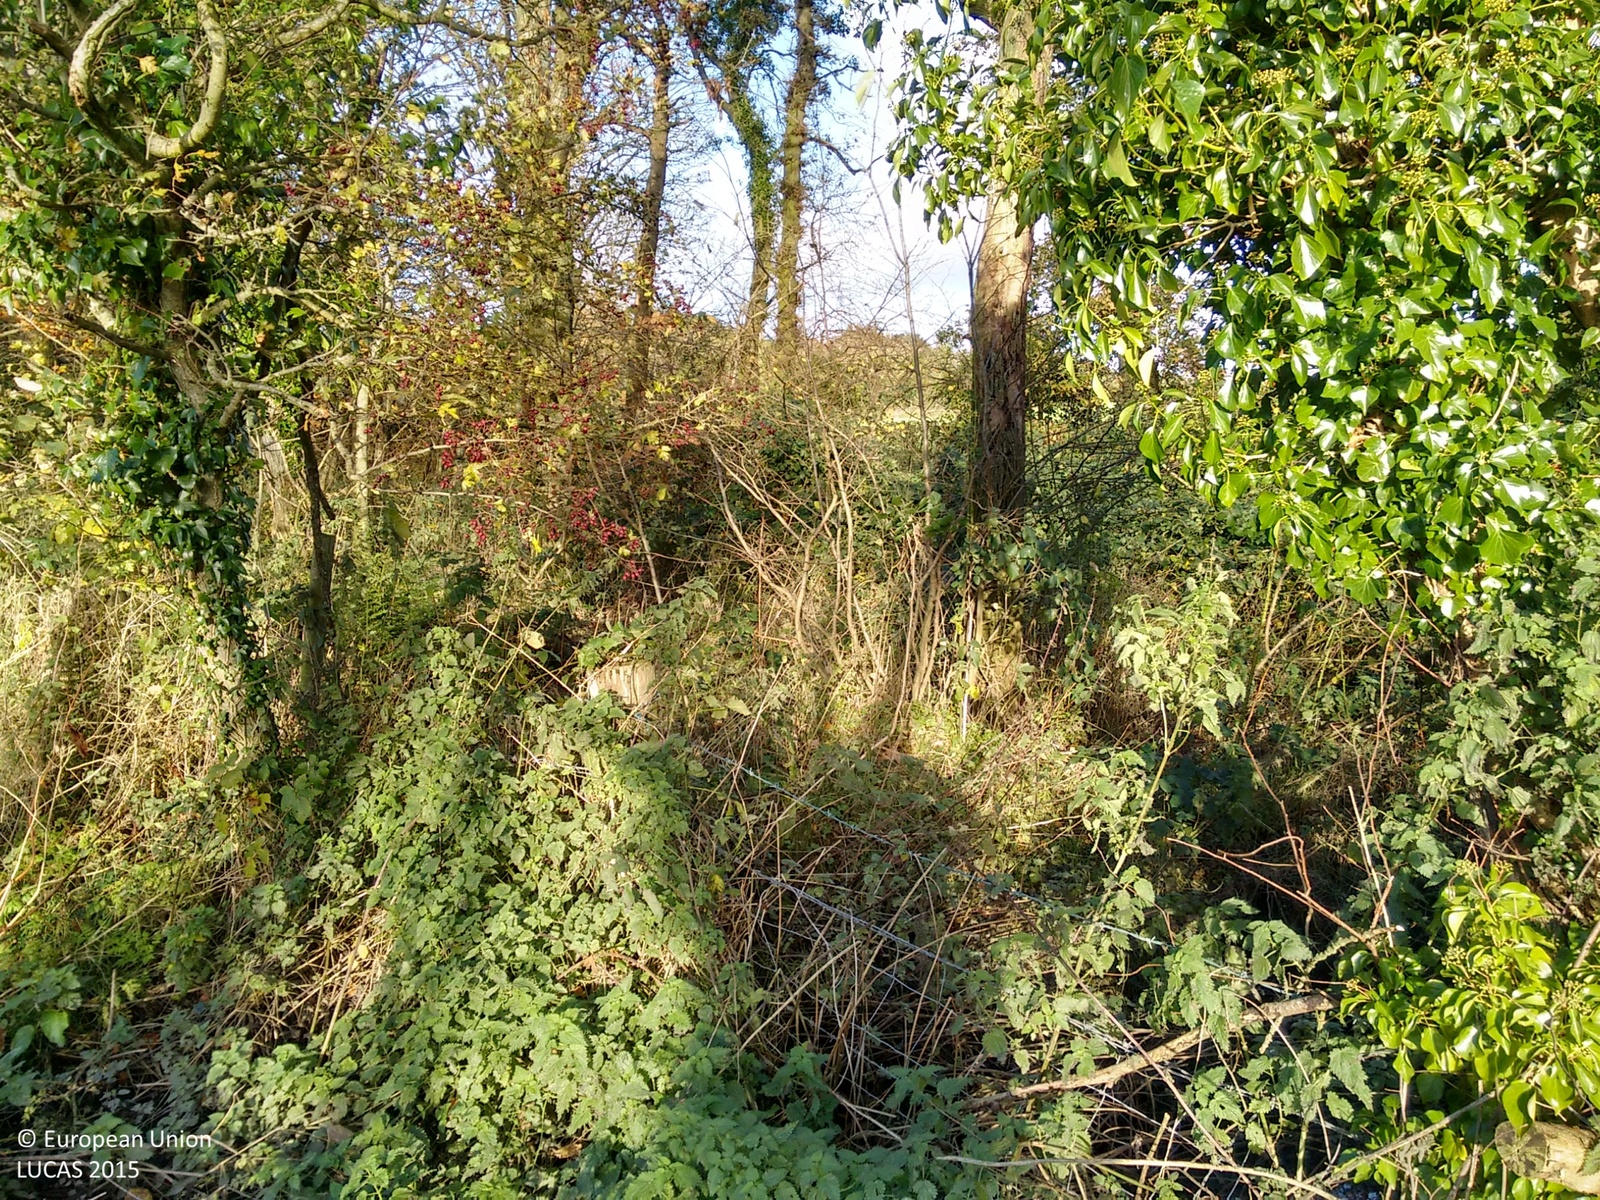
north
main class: Woodland
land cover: Broadleaved woodland
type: exotic forest
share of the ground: > 75 %
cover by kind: broadleaved forest trees 90 %, shrubs 5 %, herbaceous plants 5 %
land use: Semi-natural and natural areas not in use
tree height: > 5 m
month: November
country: GB
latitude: 54.4657
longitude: -5.5099
